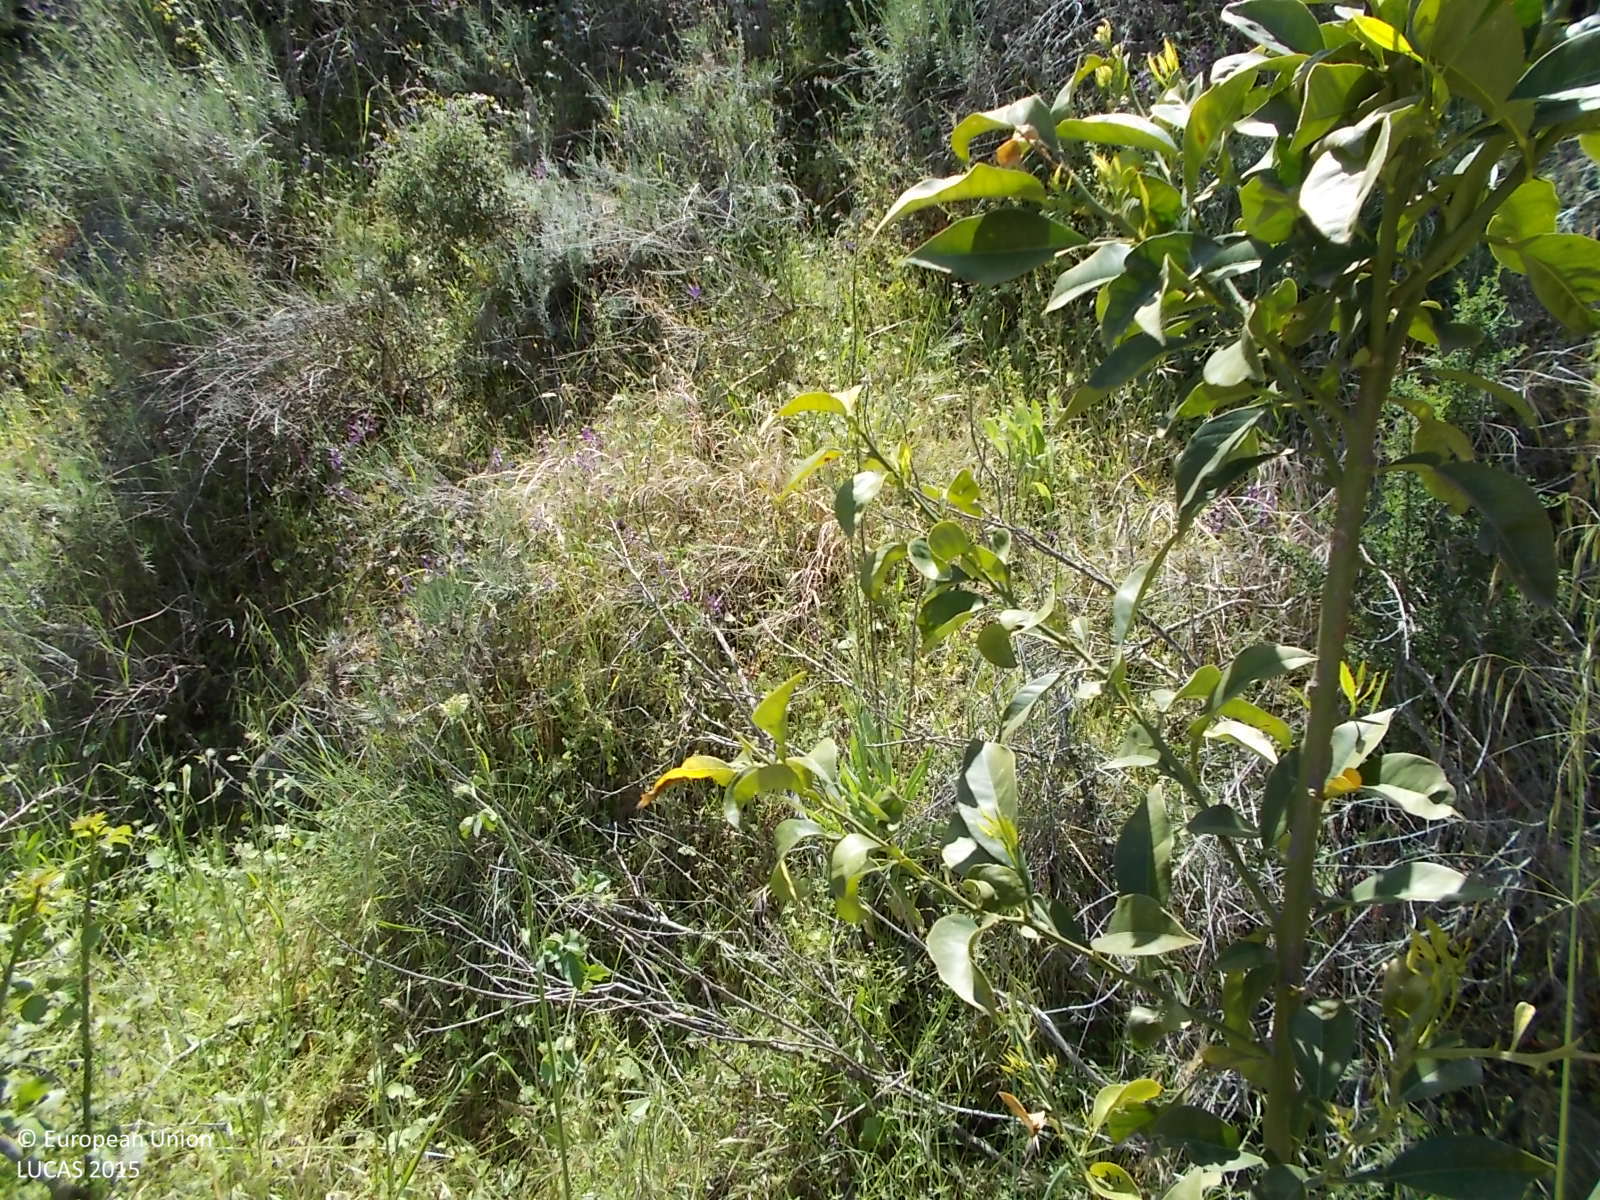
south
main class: Cropland
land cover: Other citrus fruit
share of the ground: 10 - 25 %
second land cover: Spontaneously vegetated surfaces
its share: > 75 %
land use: Abandoned areas
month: April
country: CY
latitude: 34.8248
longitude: 33.0994
